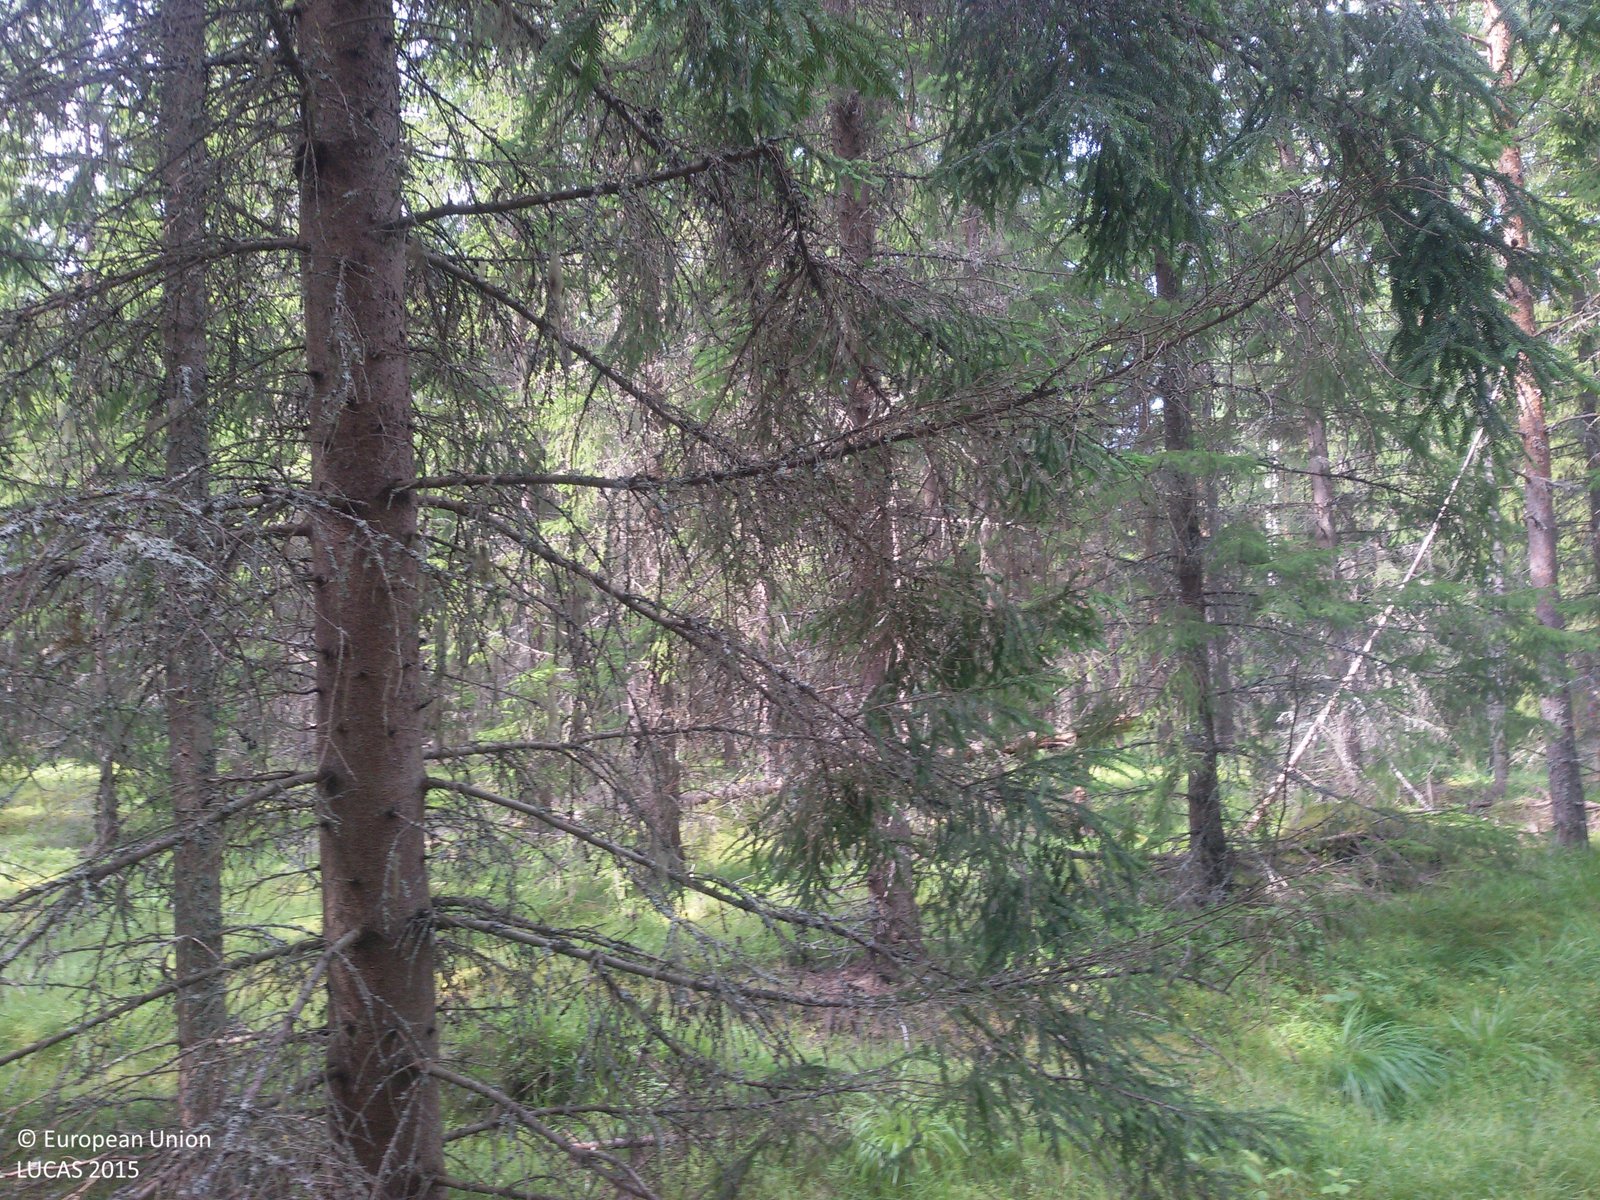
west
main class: Woodland
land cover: Spruce dominated coniferous woodland
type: boreal forest
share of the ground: > 75 %
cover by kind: coniferous forest trees 80 %, herbaceous plants 15 %, shrubs 5 %
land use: Forestry
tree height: > 5 m
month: August
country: SE
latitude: 60.4571
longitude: 16.6616
